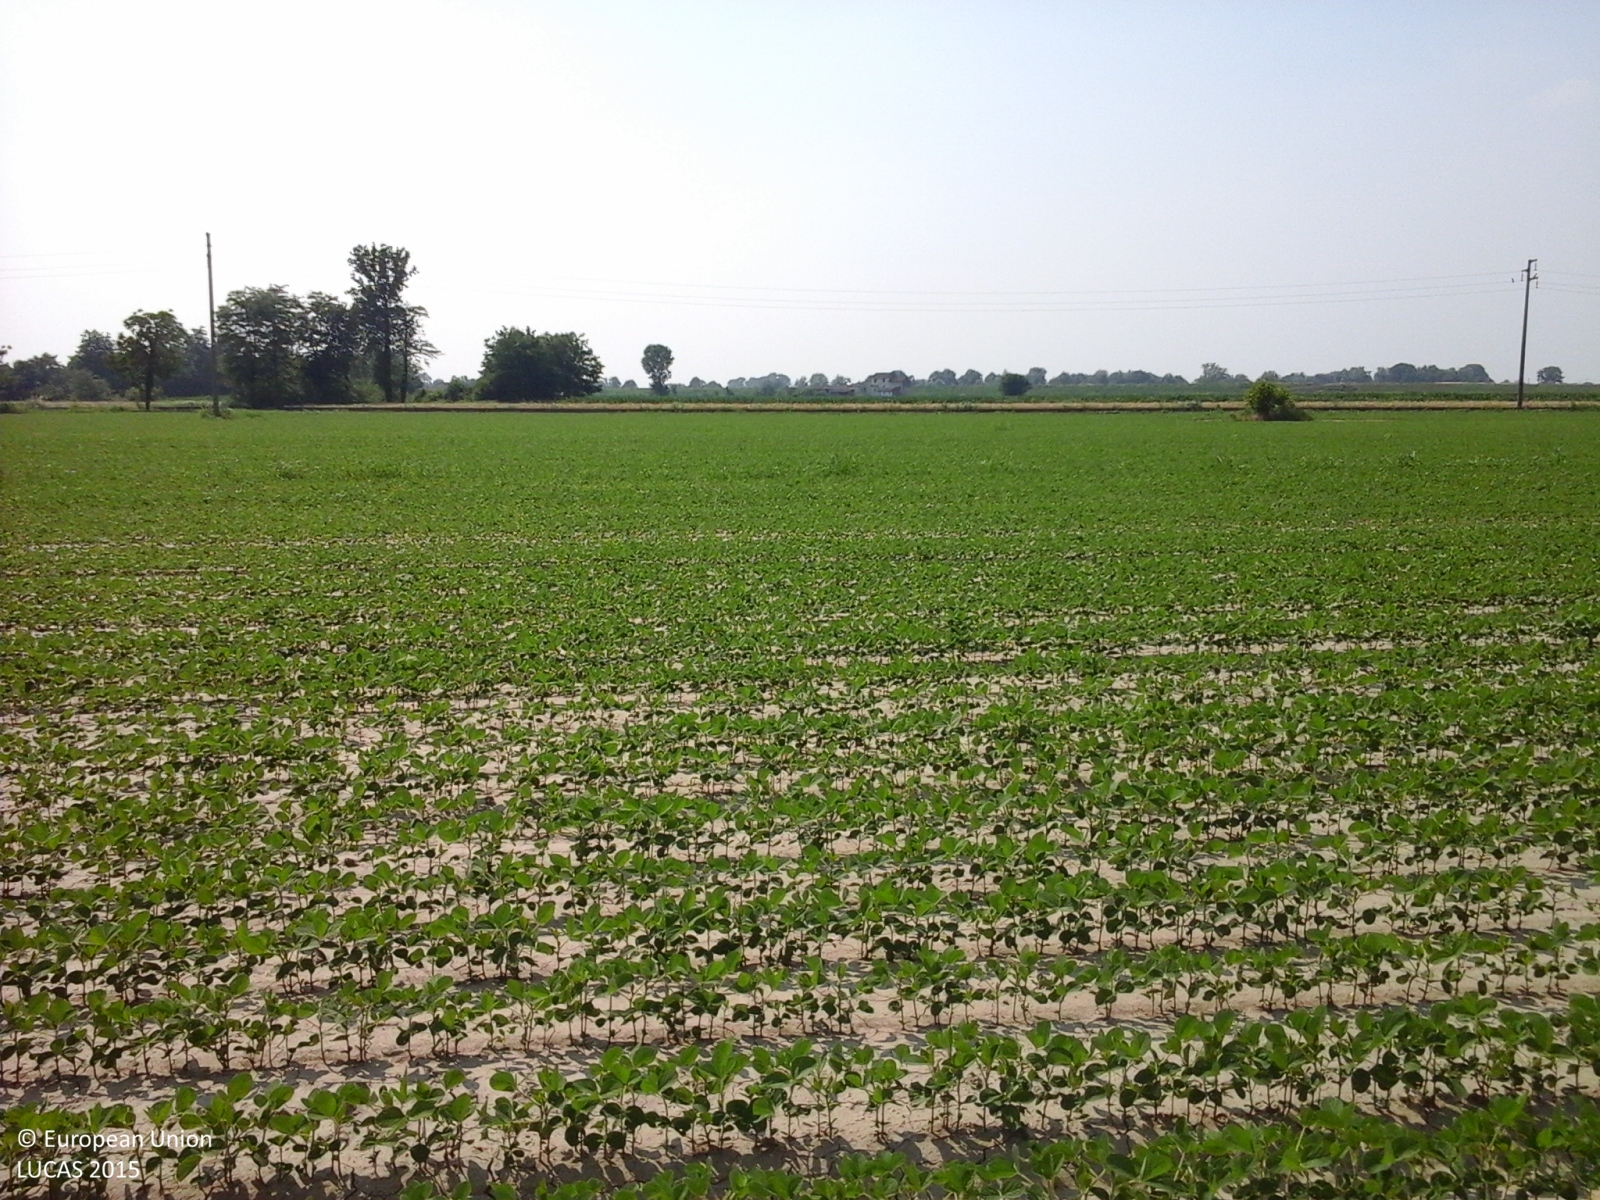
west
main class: Cropland
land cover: Soya
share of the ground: 25 - 50 %
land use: Agriculture (excluding fallow land and kitchen gardens)
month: June
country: IT
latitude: 45.1073
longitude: 9.6575
